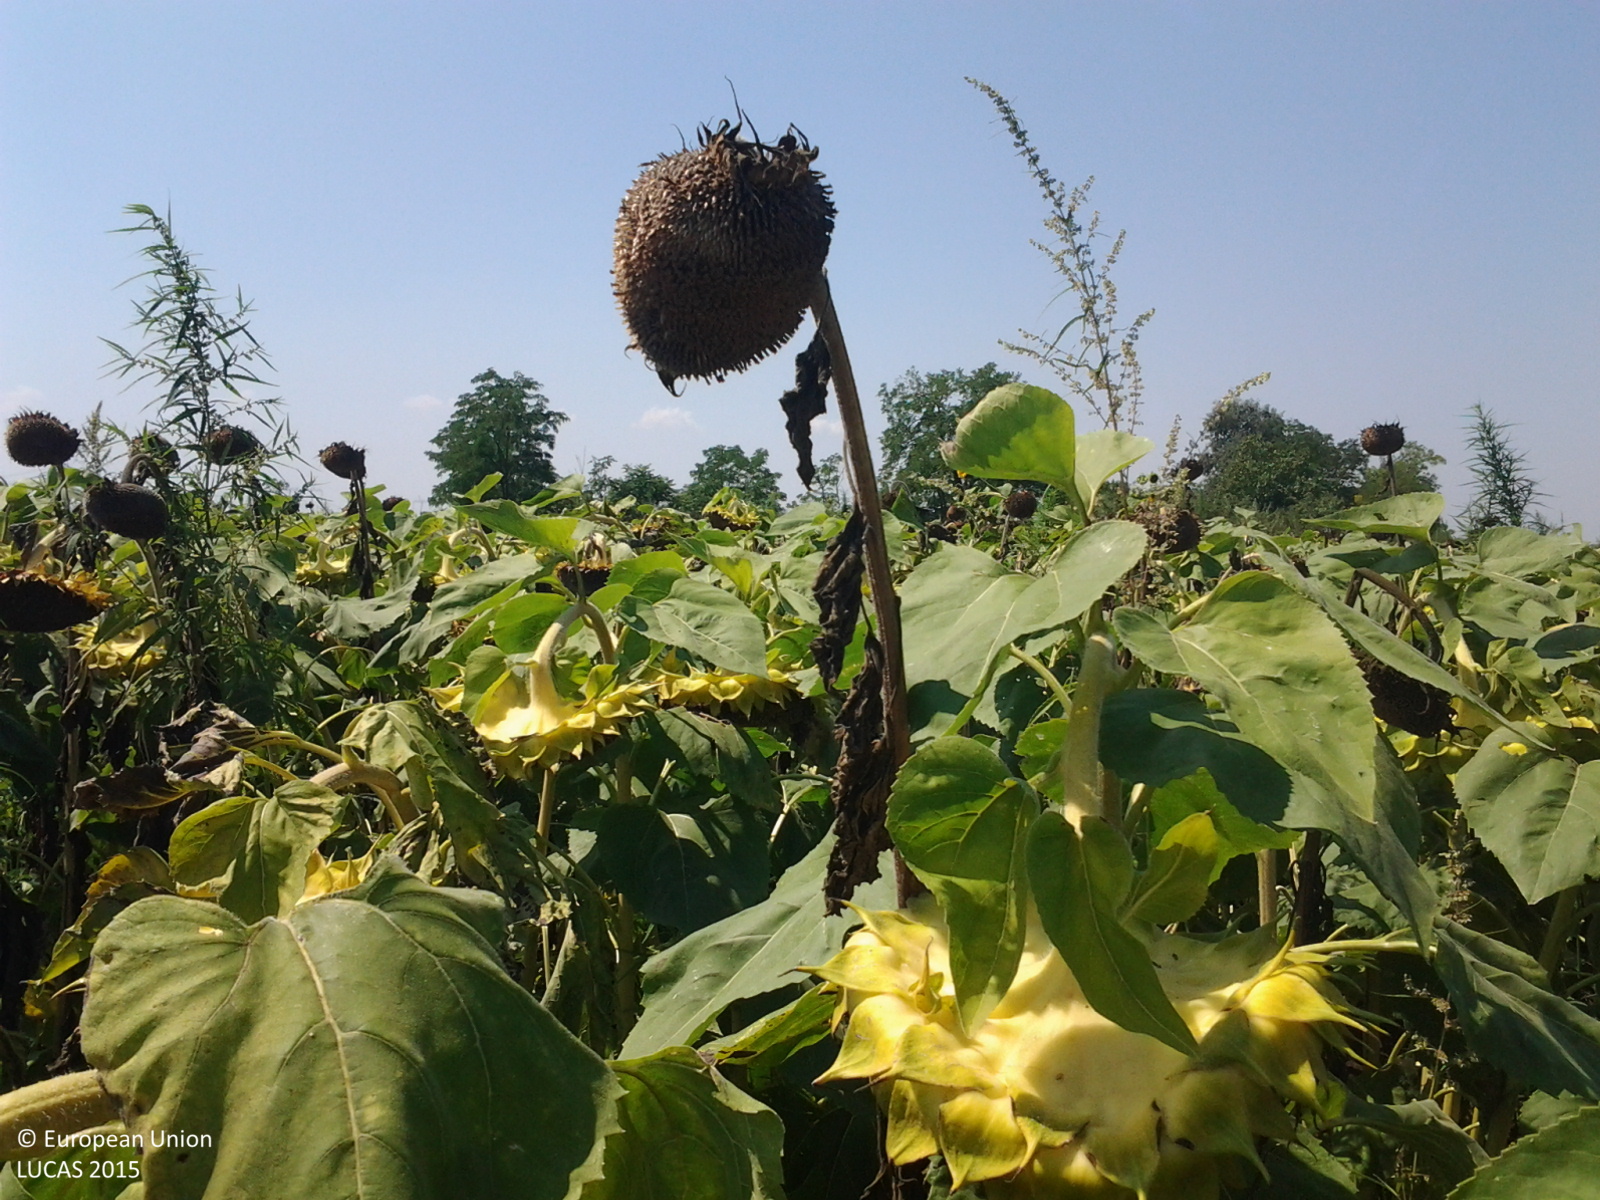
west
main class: Cropland
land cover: Sunflower
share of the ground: > 75 %
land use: Agriculture (excluding fallow land and kitchen gardens)
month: August
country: HU
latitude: 47.2386
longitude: 19.8384
